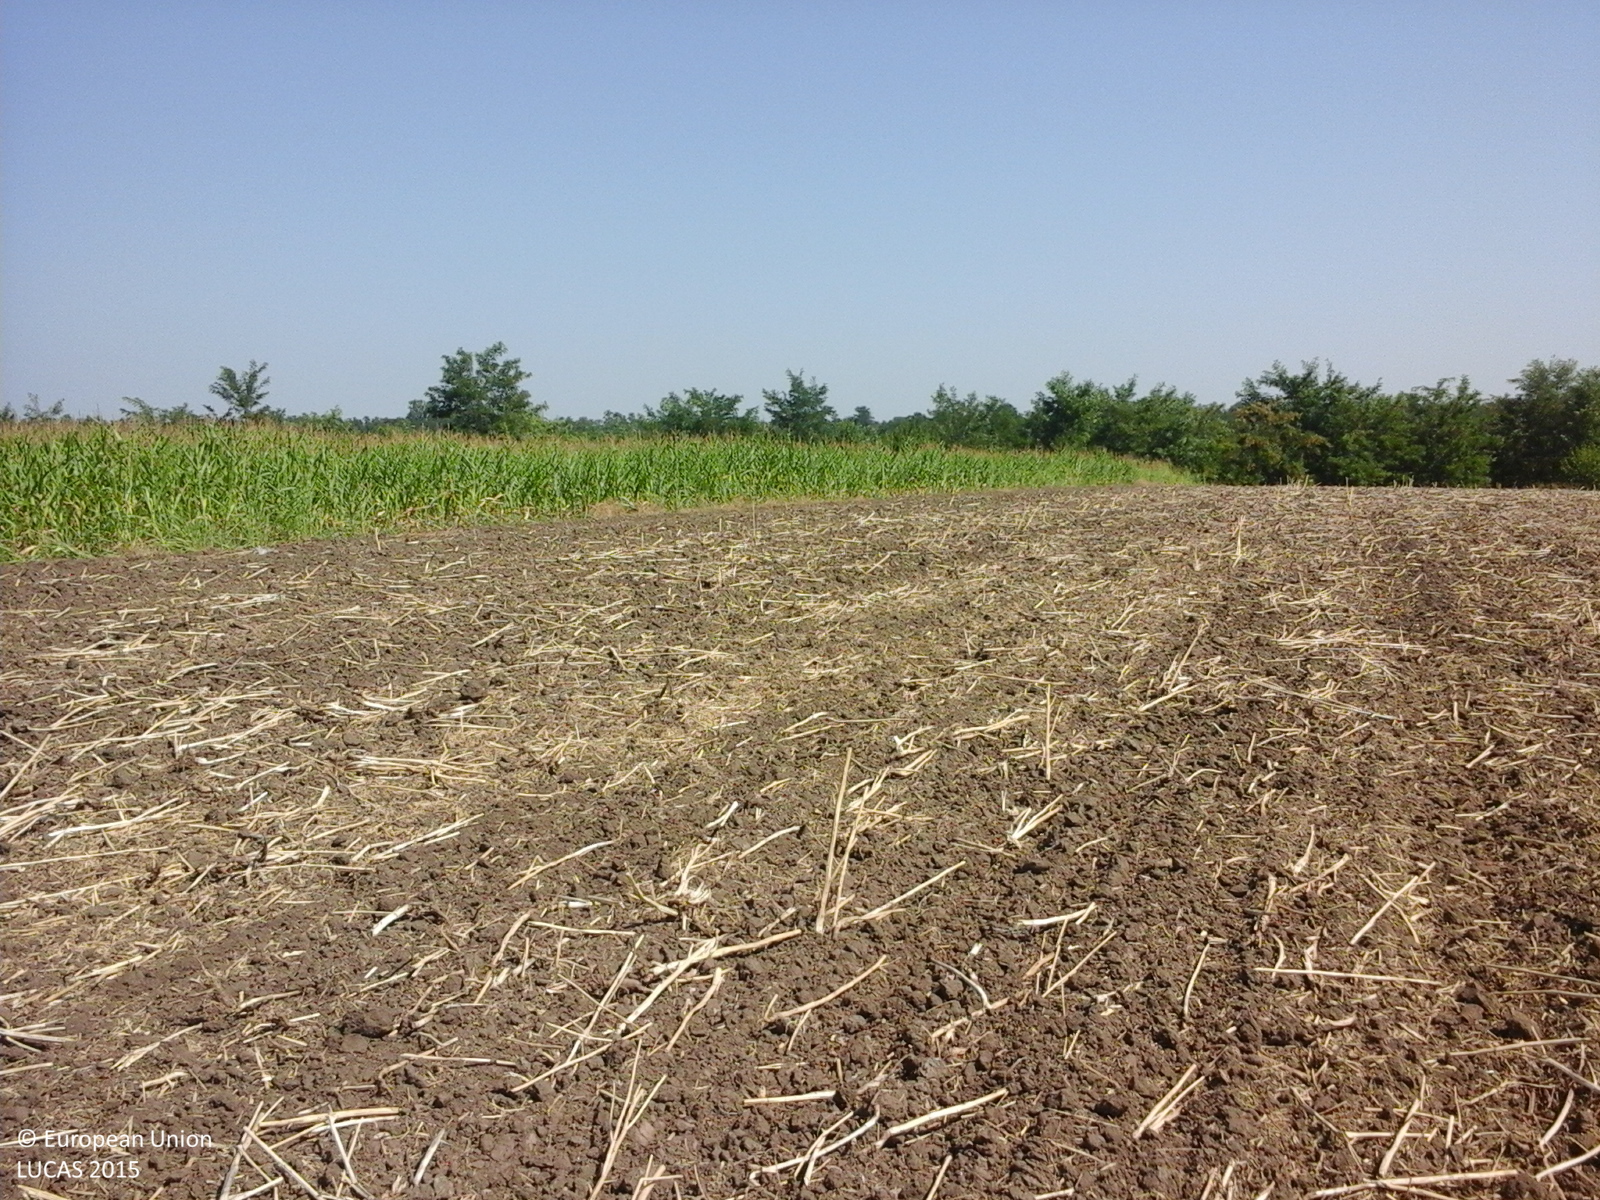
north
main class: Cropland
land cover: Rape and turnip rape
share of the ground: < 10 %
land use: Agriculture (excluding fallow land and kitchen gardens)
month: July
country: RO
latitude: 44.3397
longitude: 27.0743
